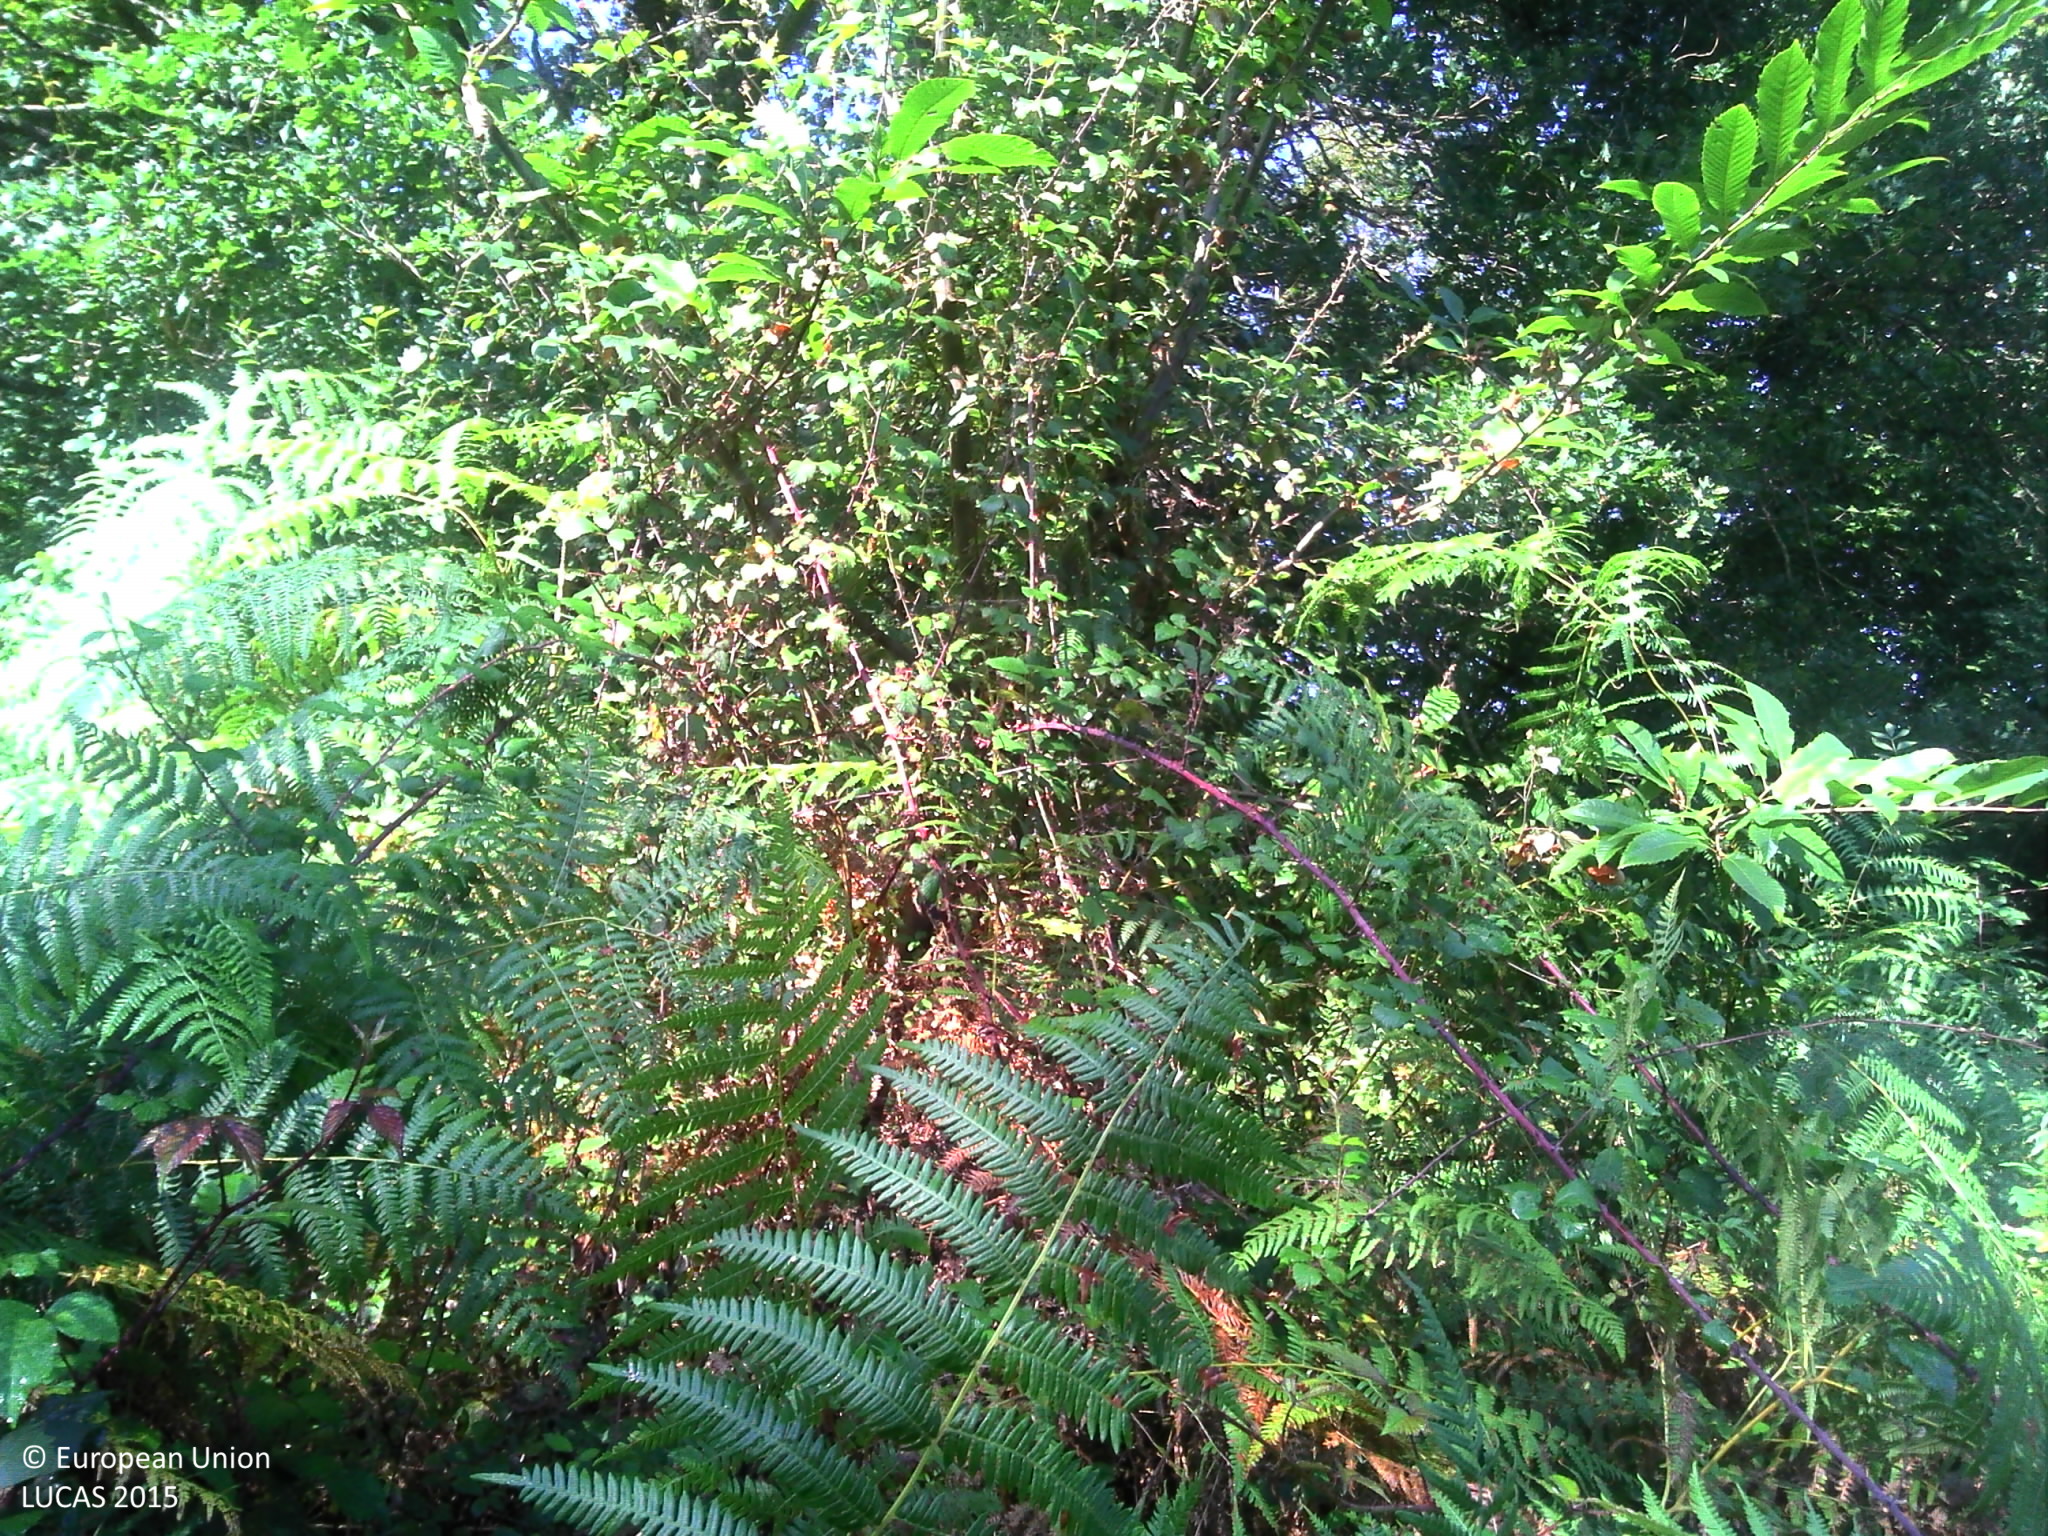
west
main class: Shrubland
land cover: Shrubland with sparse tree cover
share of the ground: > 75 %
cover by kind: shrubs 55 %, herbaceous plants 40 %, broadleaved forest trees 5 %
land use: Semi-natural and natural areas not in use
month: September
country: FR
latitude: 43.1033
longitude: -0.8839
